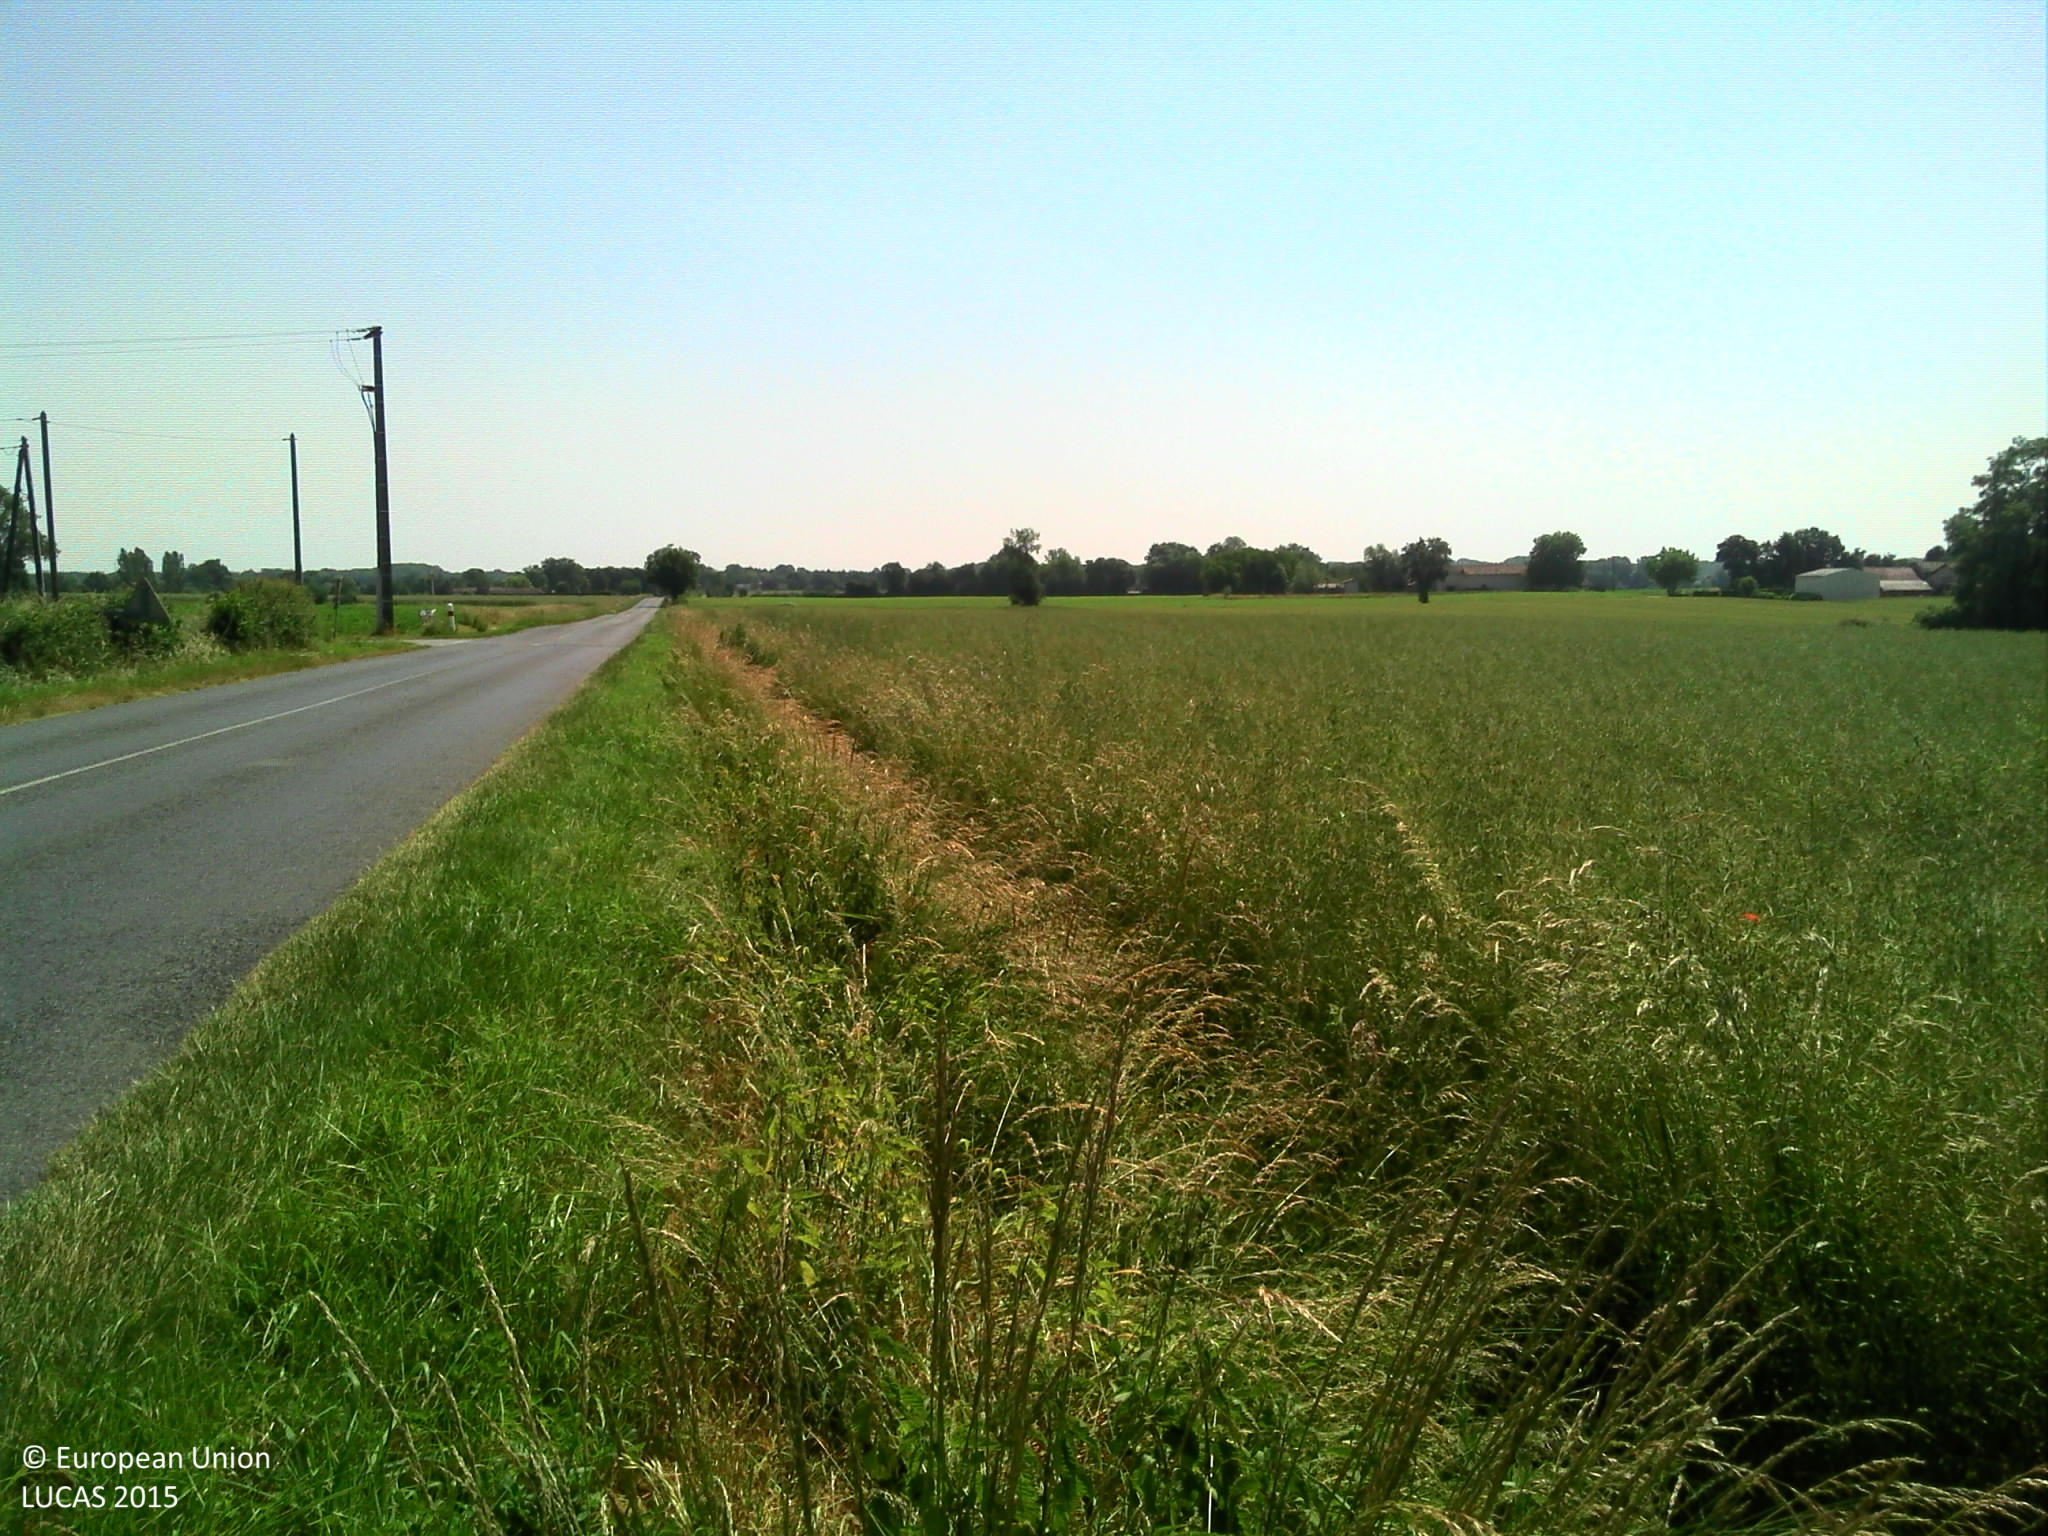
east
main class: Cropland
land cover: Rape and turnip rape
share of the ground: > 75 %
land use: Agriculture (excluding fallow land and kitchen gardens)
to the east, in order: Rape and turnip rape; Ditches and canals; Common wheat
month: June
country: FR
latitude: 45.9579
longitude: 4.8808
